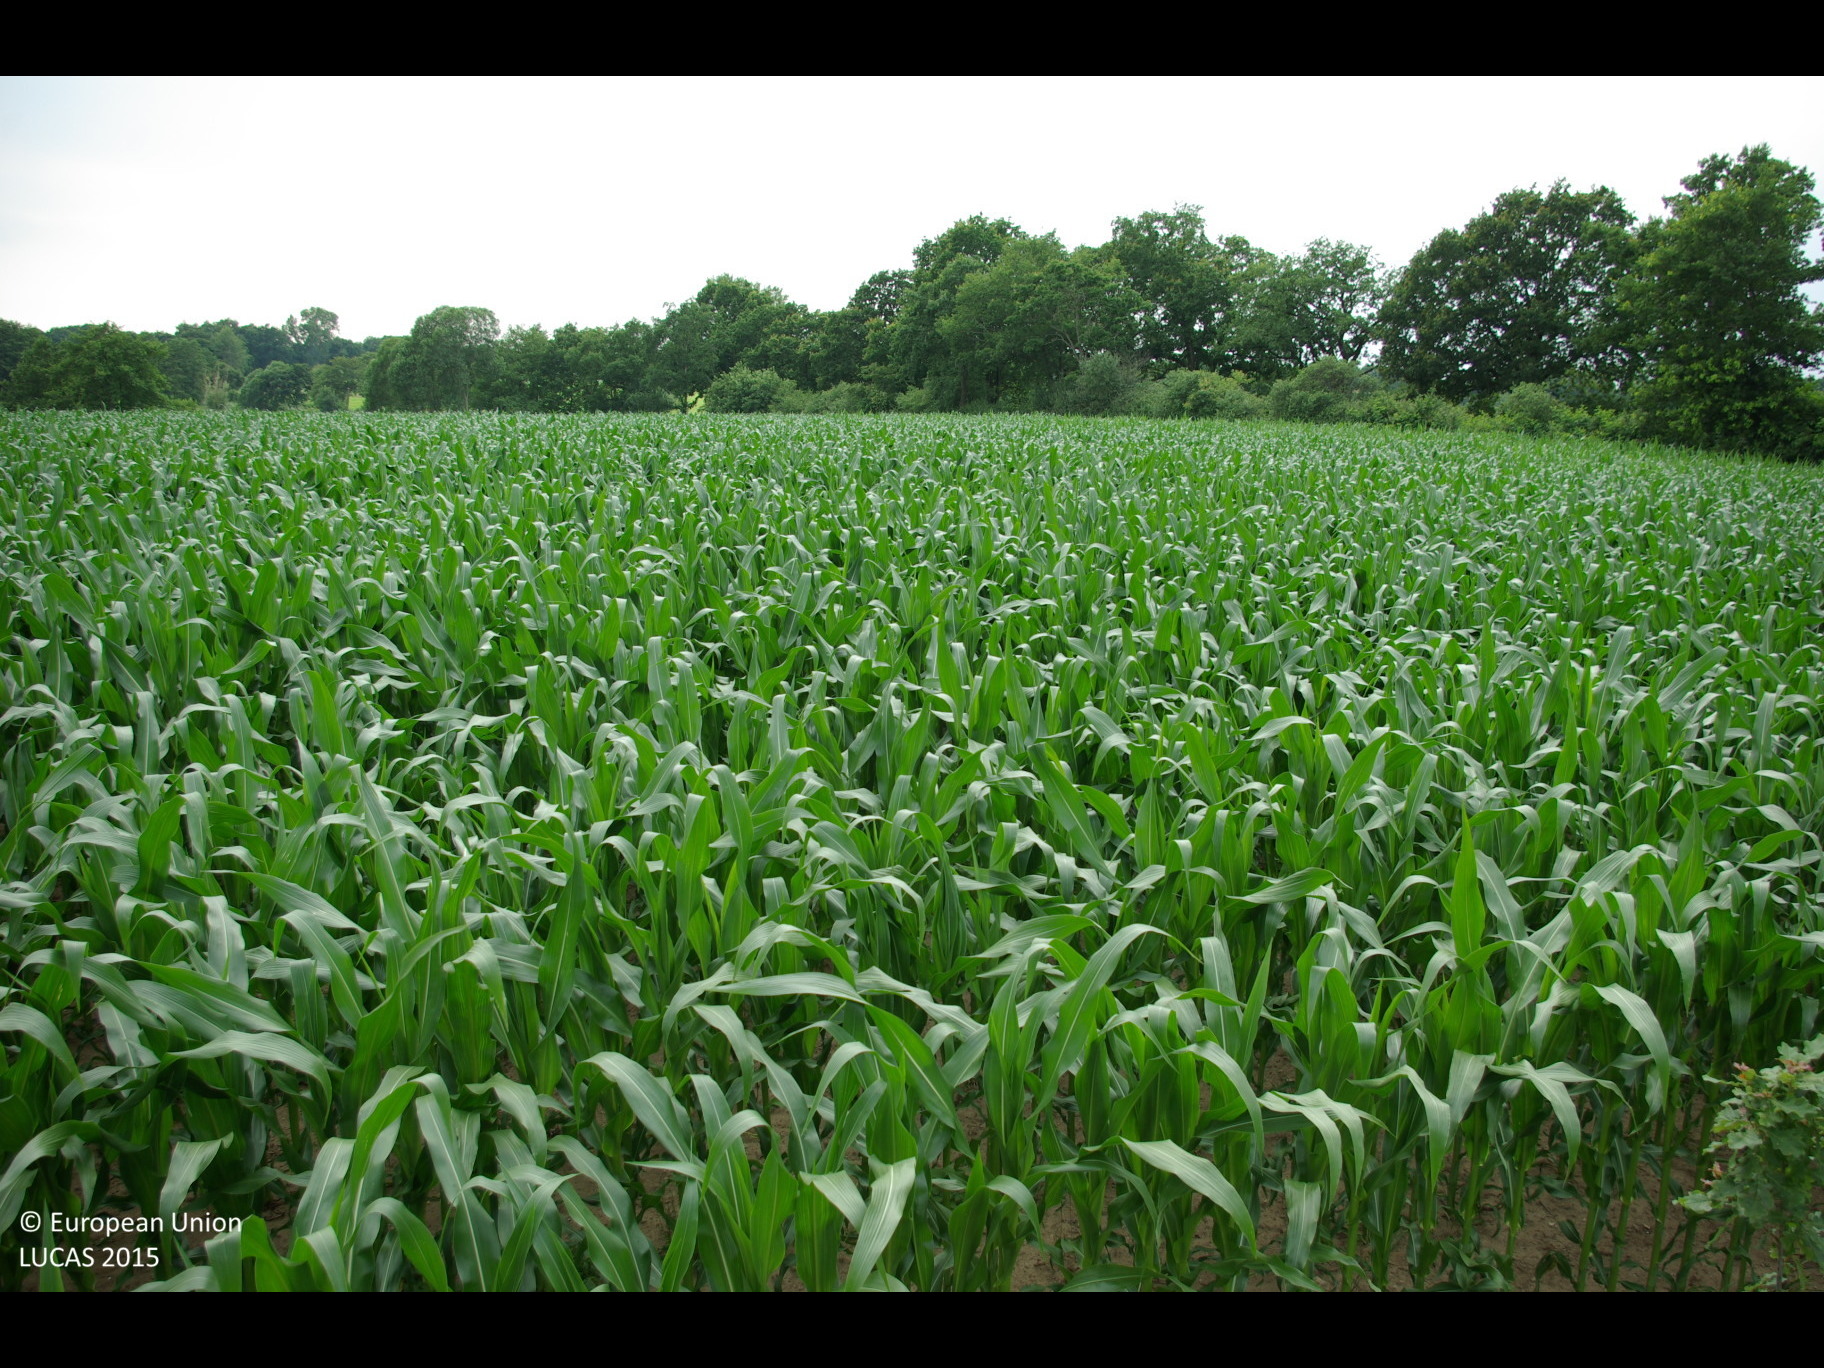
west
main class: Cropland
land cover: Maize
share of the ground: > 75 %
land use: Agriculture (excluding fallow land and kitchen gardens)
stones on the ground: 25 - 50 %
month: July
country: DE
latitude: 54.2267
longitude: 9.3102
